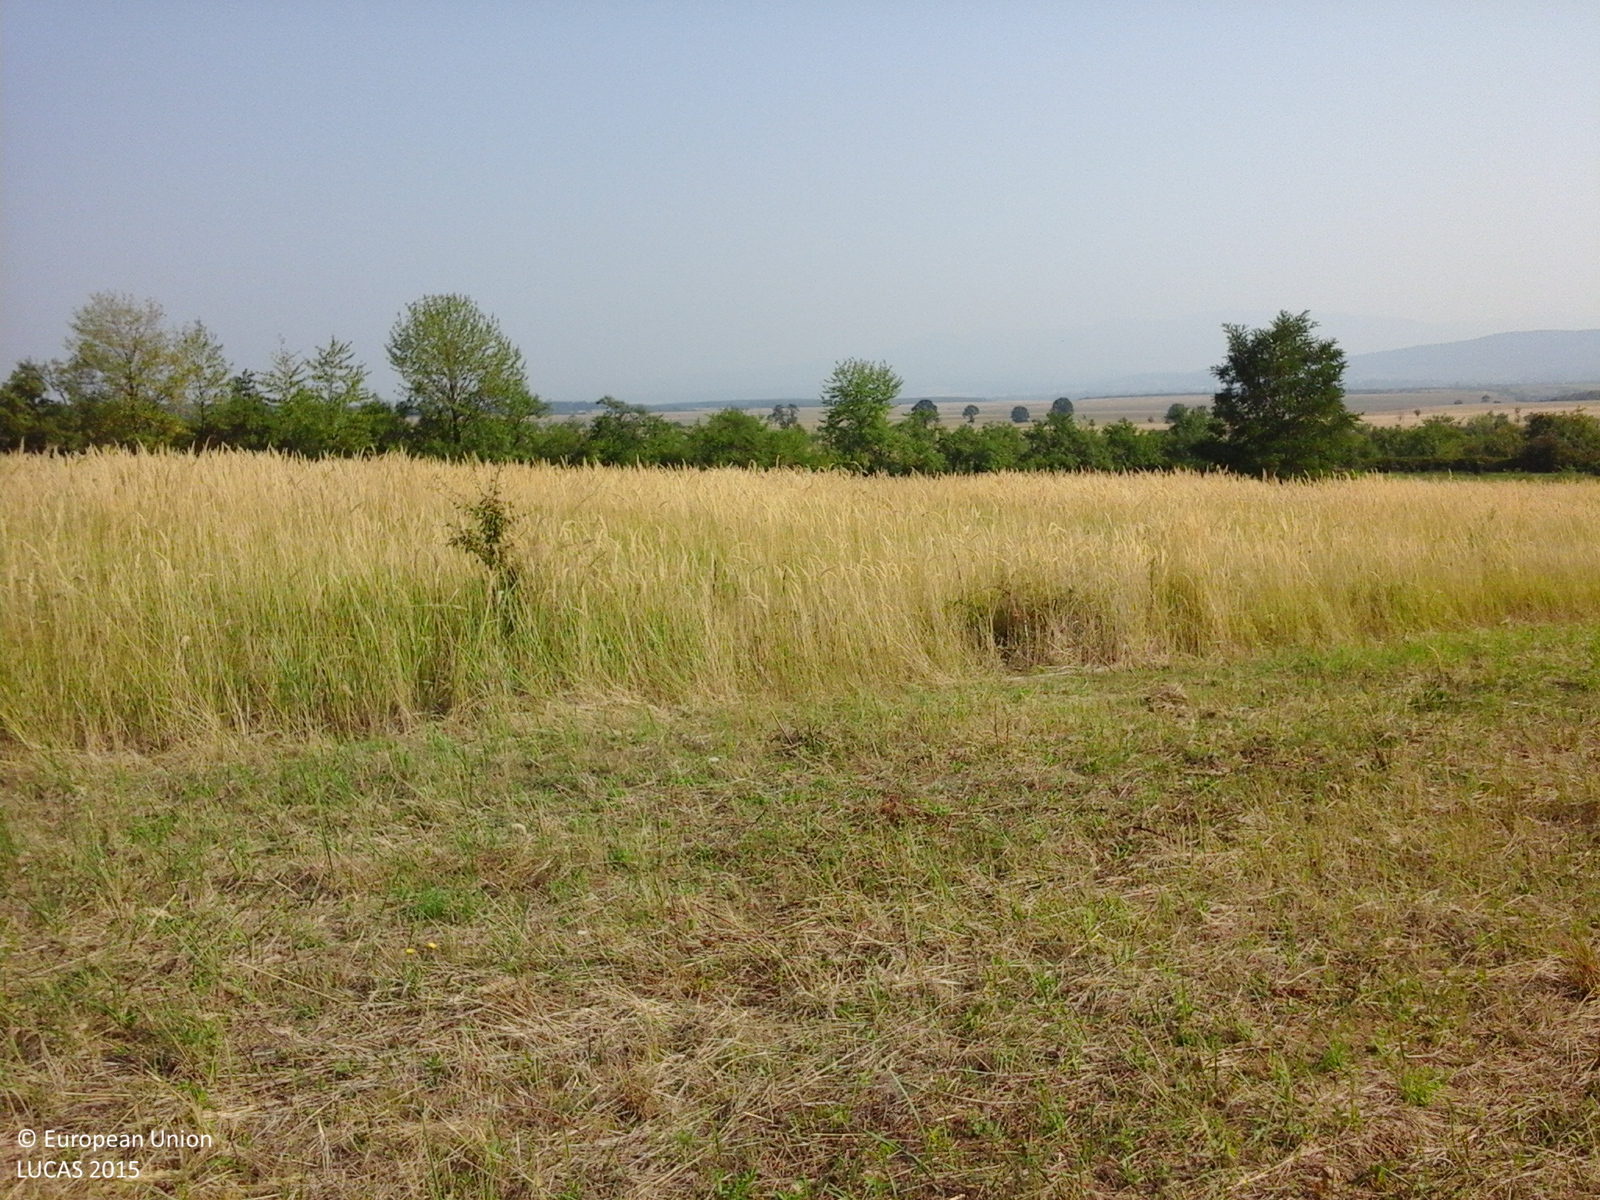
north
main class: Grassland
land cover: Grassland without tree/shrub cover
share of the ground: > 75 %
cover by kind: herbaceous plants 100 %
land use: Agriculture (excluding fallow land and kitchen gardens)
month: August
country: RO
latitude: 46.3009
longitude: 22.0795
